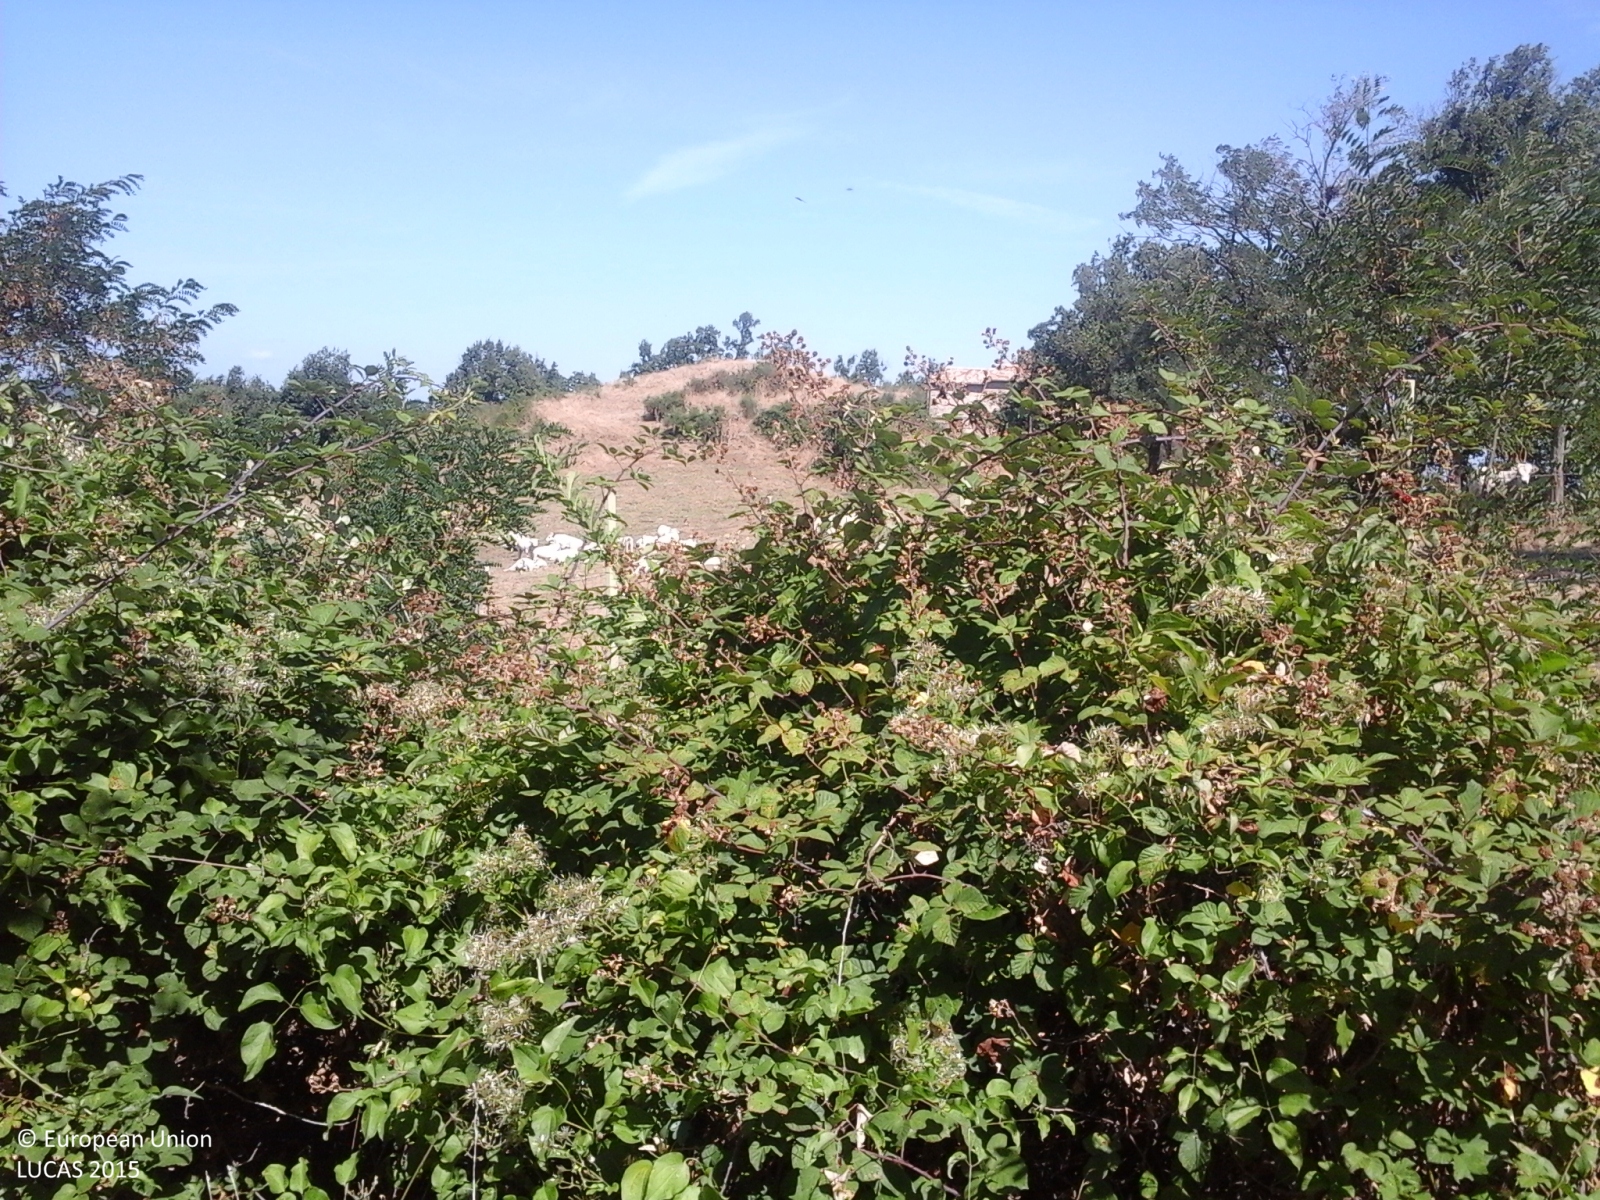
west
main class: Woodland
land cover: Broadleaved woodland
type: thermophilous deciduous forest
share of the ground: > 75 %
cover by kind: broadleaved forest trees 75 %, shrubs 25 %
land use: Forestry
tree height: > 5 m
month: July
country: IT
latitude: 43.9478
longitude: 12.2250
